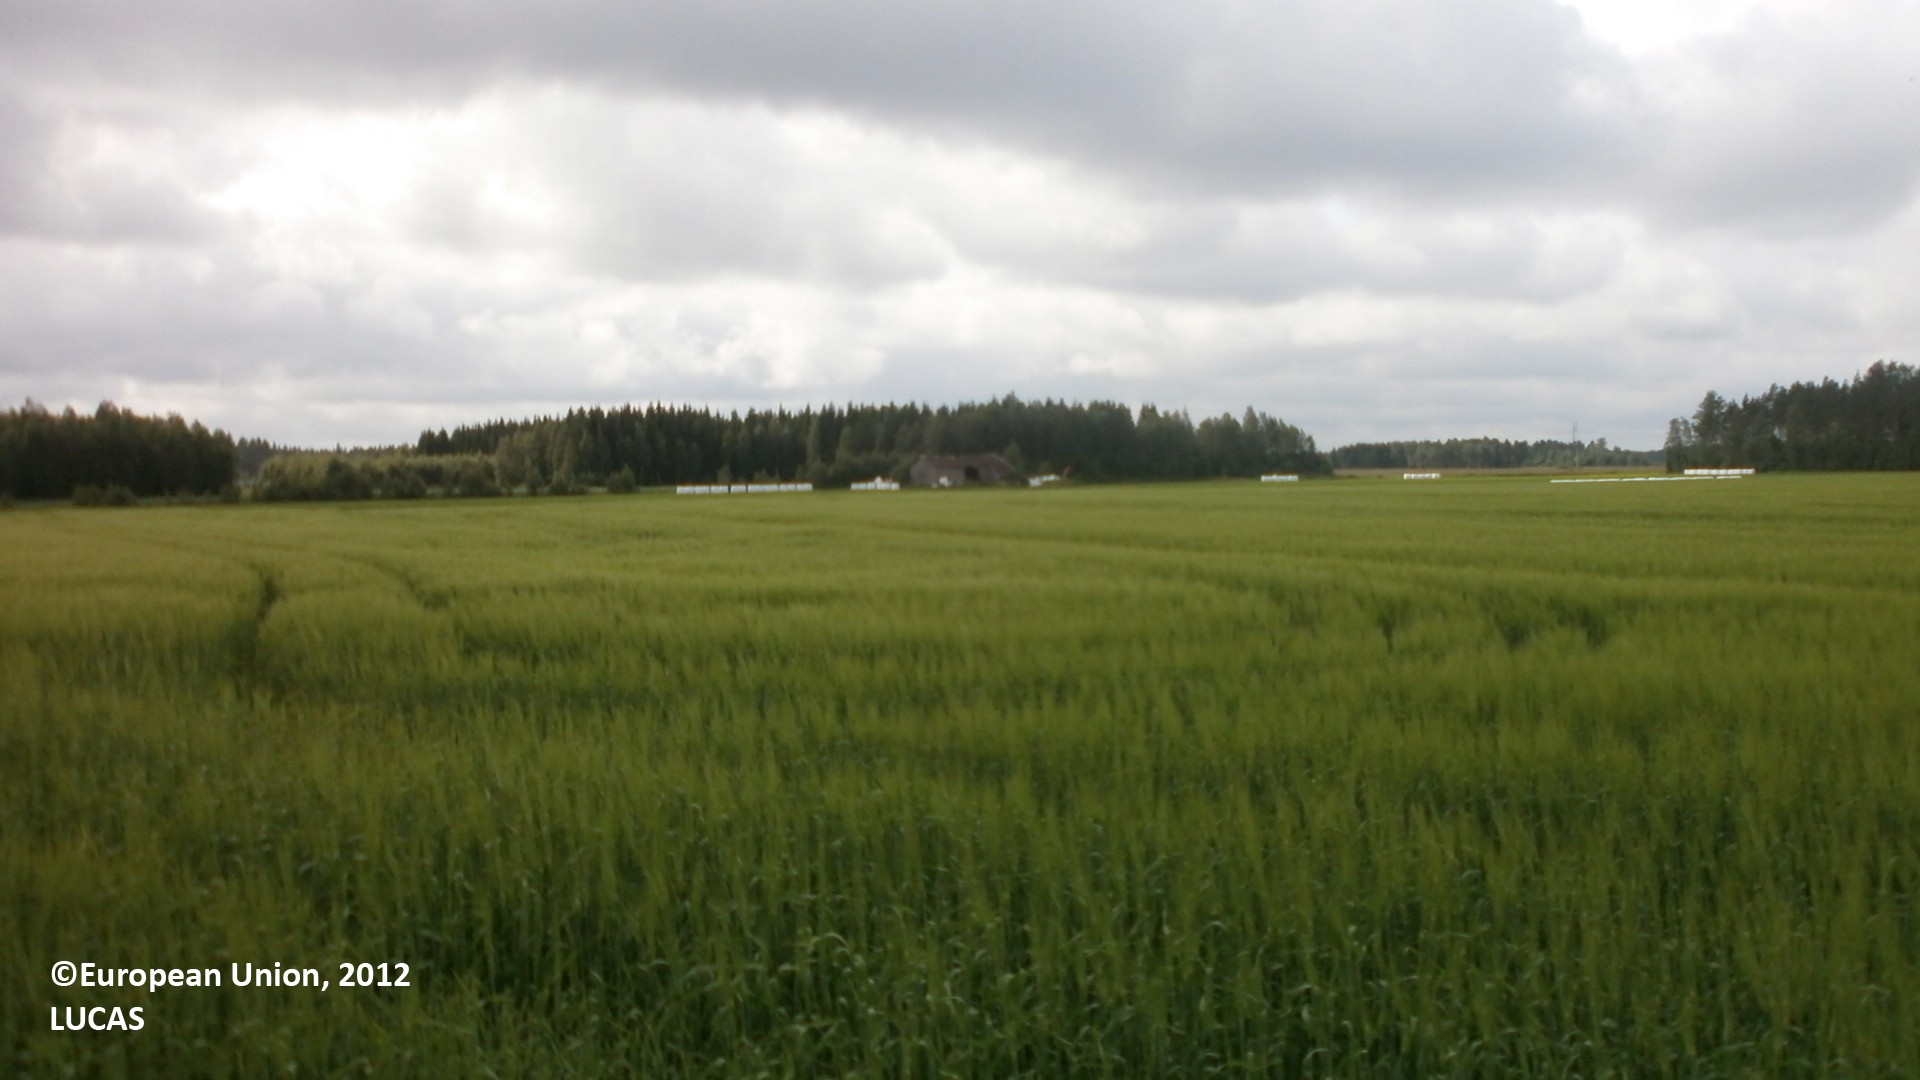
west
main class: Cropland
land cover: Barley
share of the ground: > 75 %
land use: Agriculture (excluding fallow land and kitchen gardens)
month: July
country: FI
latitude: 64.1851
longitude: 24.3328
